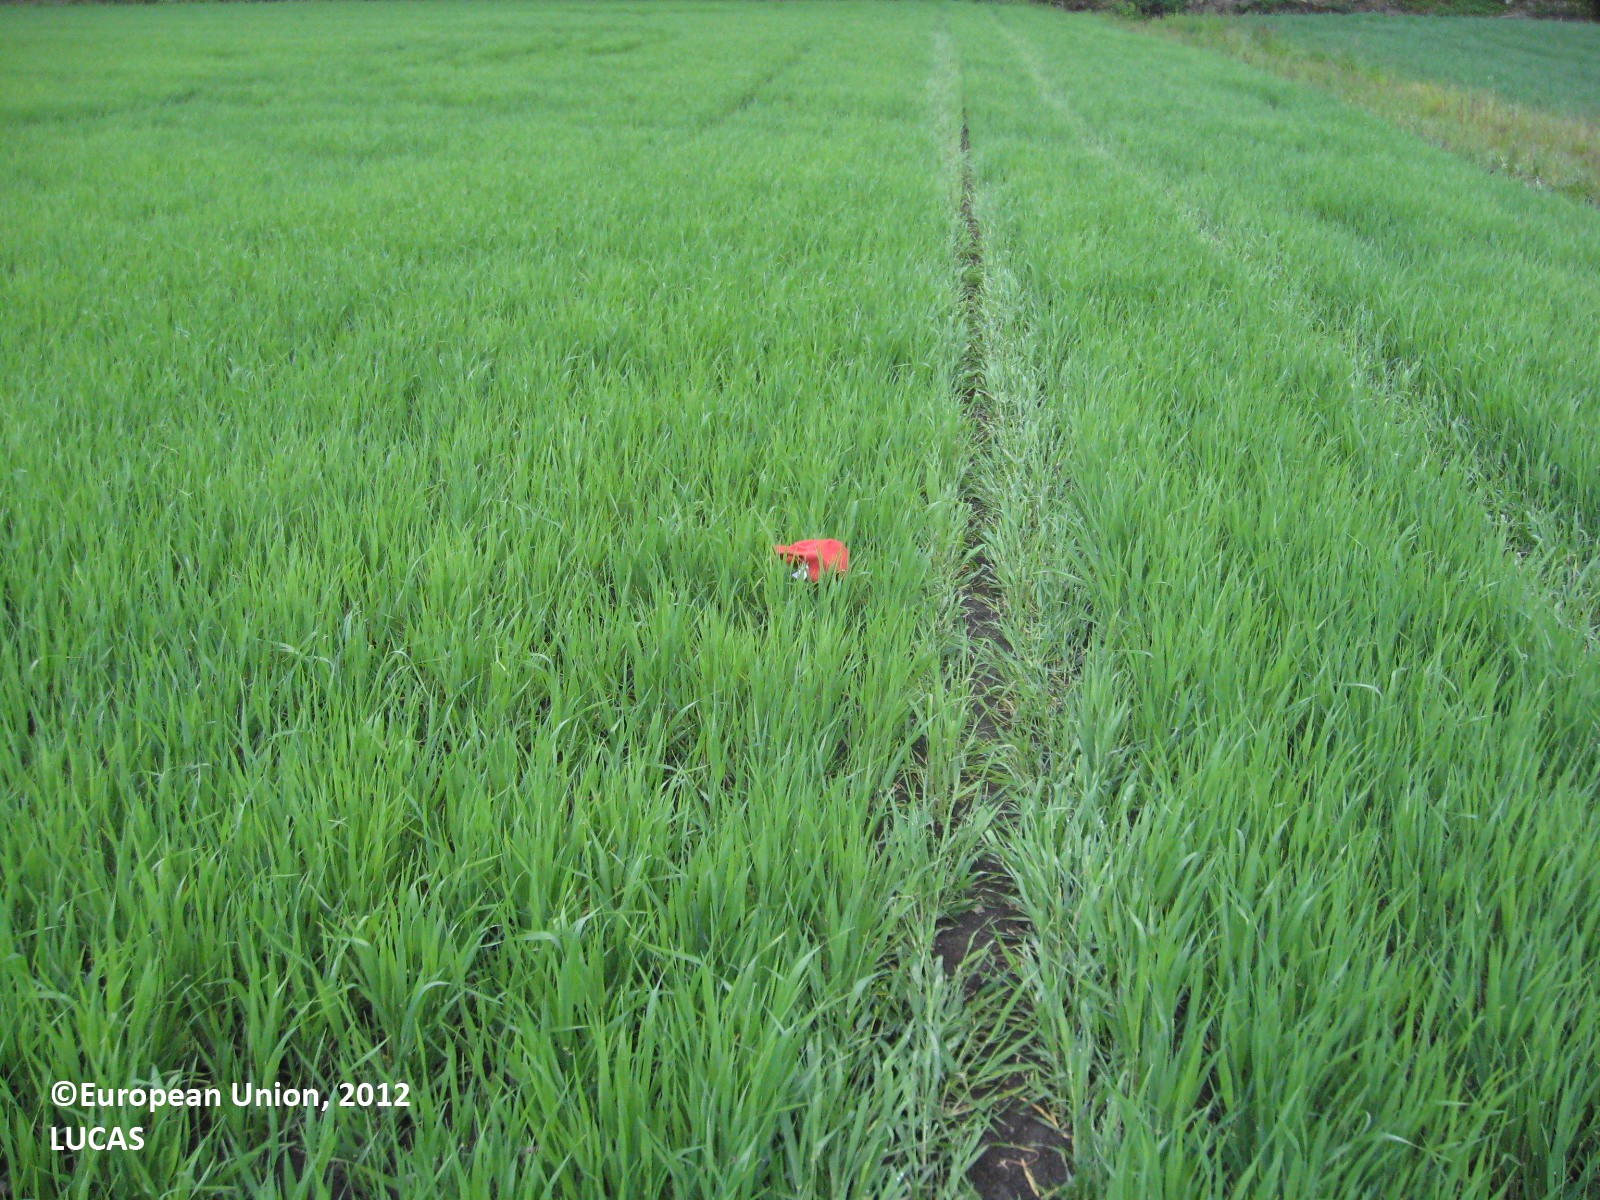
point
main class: Cropland
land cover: Barley
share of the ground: > 75 %
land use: Agriculture (excluding fallow land and kitchen gardens)
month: June
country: FI
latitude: 62.9406
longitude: 22.6047
